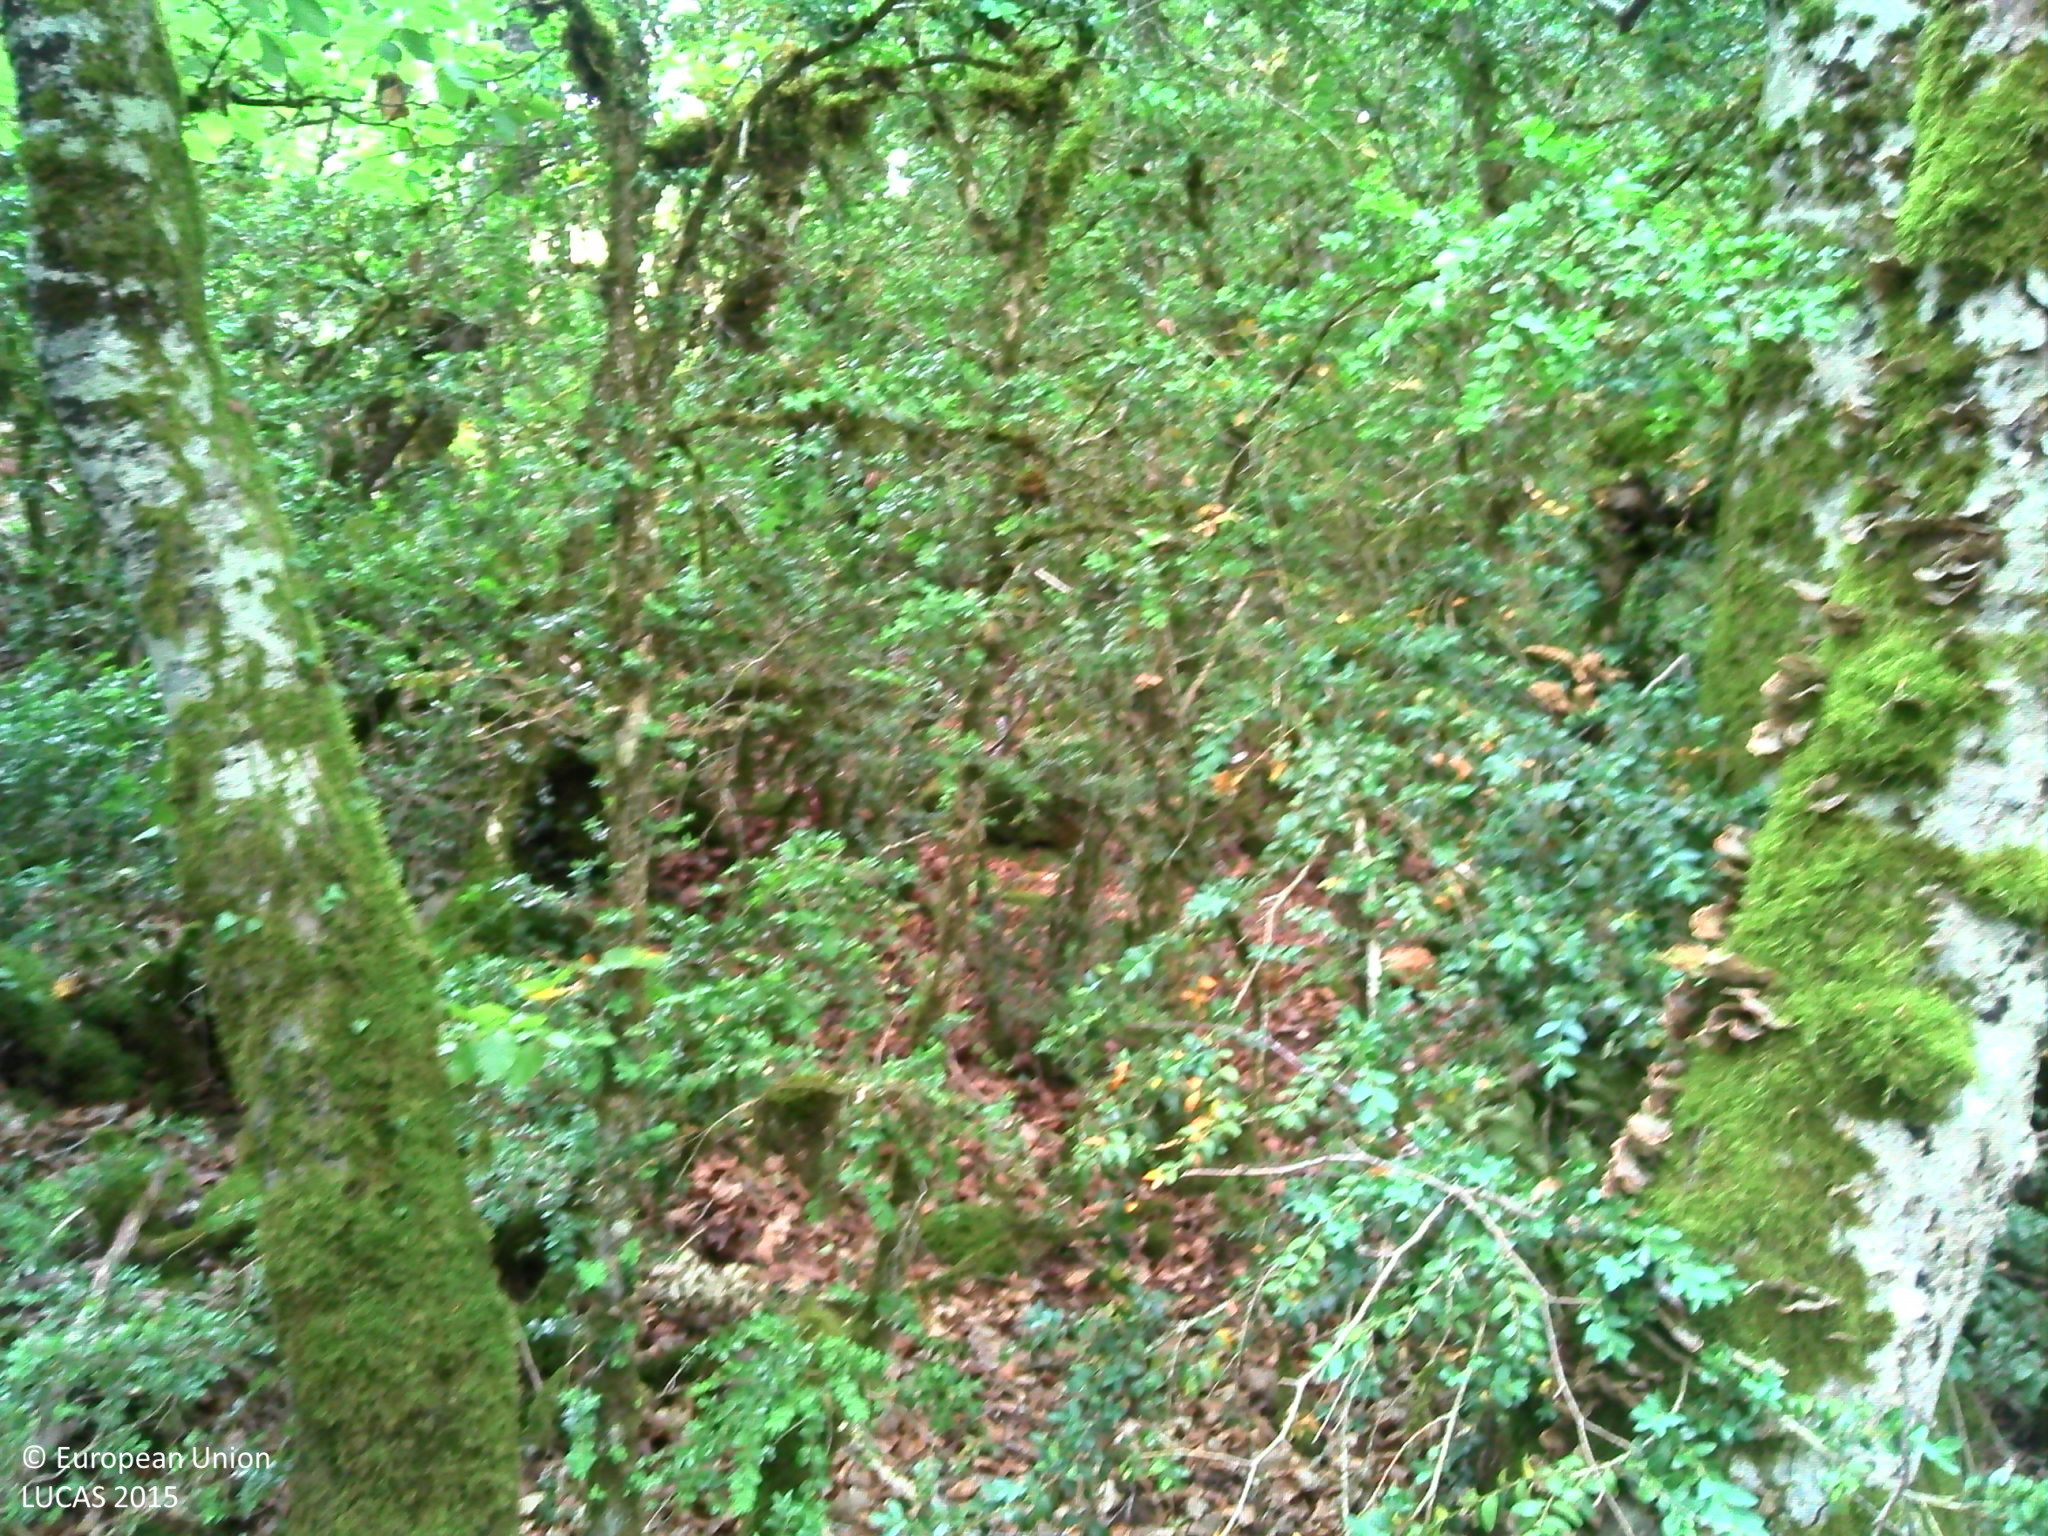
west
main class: Woodland
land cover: Broadleaved woodland
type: acidophilous oak and oak-birch forest
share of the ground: > 75 %
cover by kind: broadleaved forest trees 80 %, shrubs 10 %, herbaceous plants 5 %, lichens and mosses 5 %
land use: Forestry
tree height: > 5 m
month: July
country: FR
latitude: 44.4189
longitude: 2.9583
